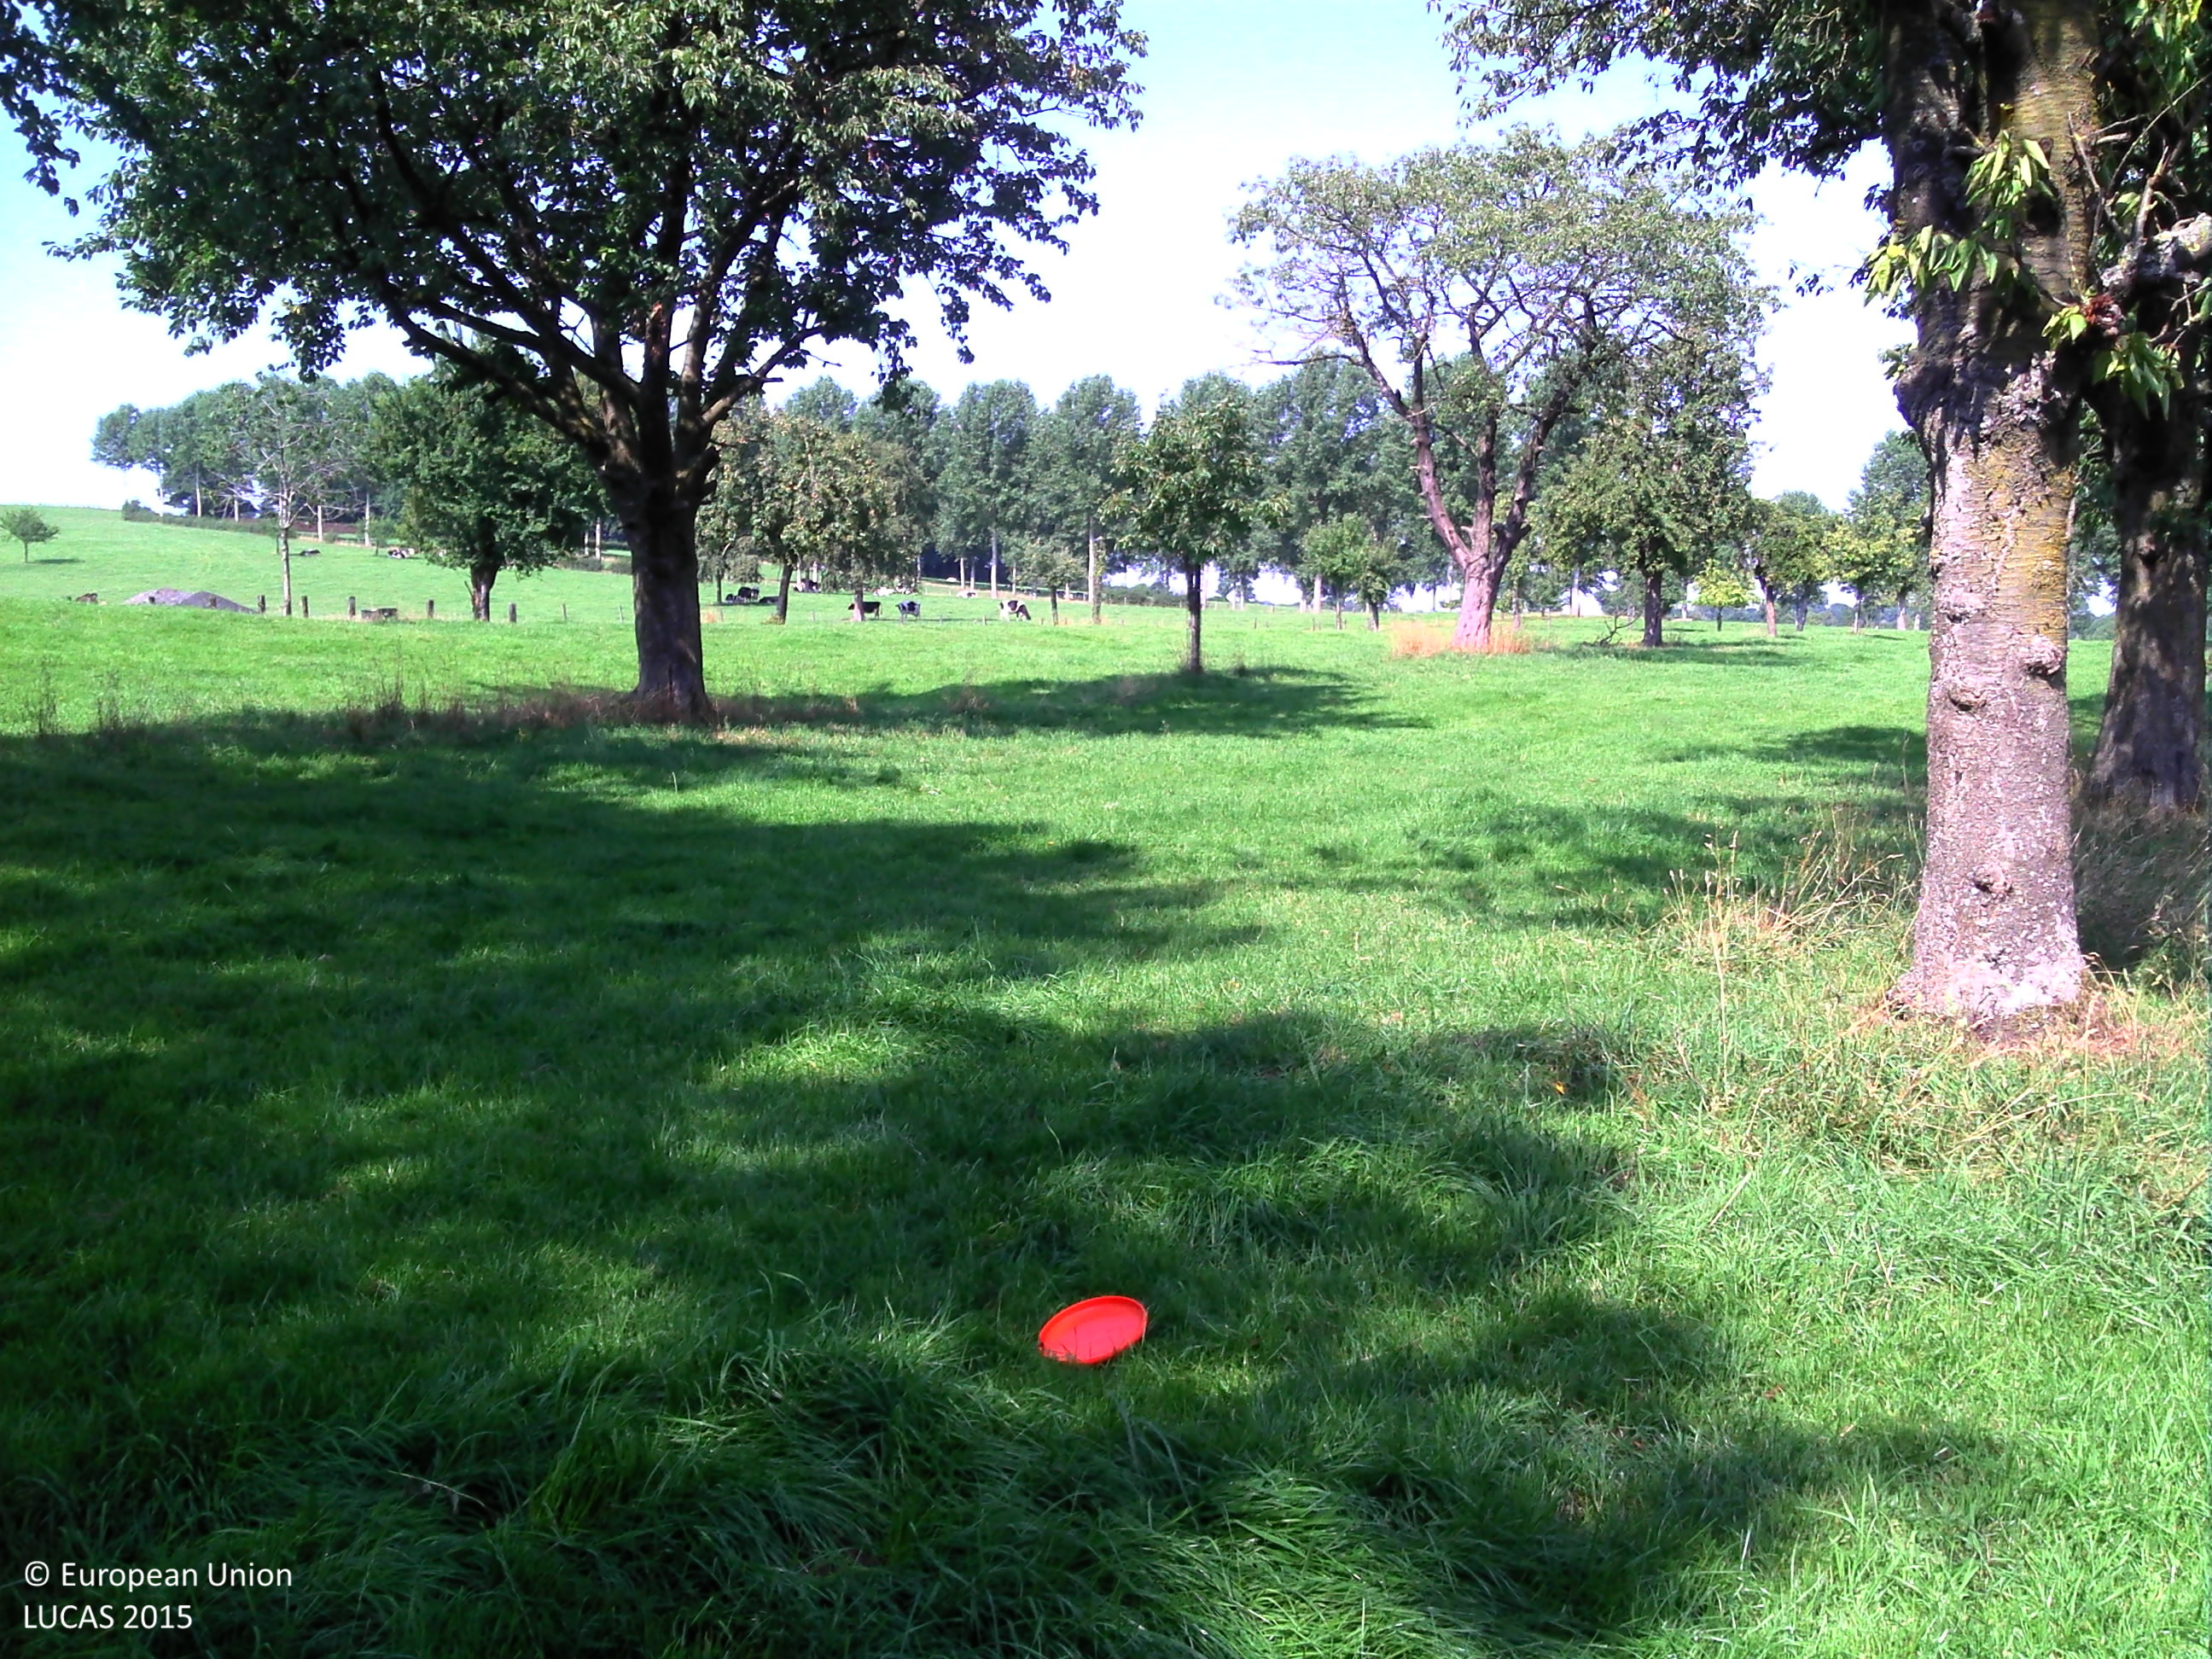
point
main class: Cropland
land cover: Cherry fruit
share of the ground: 25 - 50 %
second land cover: Grassland without tree/shrub cover
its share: > 75 %
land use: Agriculture (excluding fallow land and kitchen gardens)
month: August
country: BE
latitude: 50.7378
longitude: 5.8186
